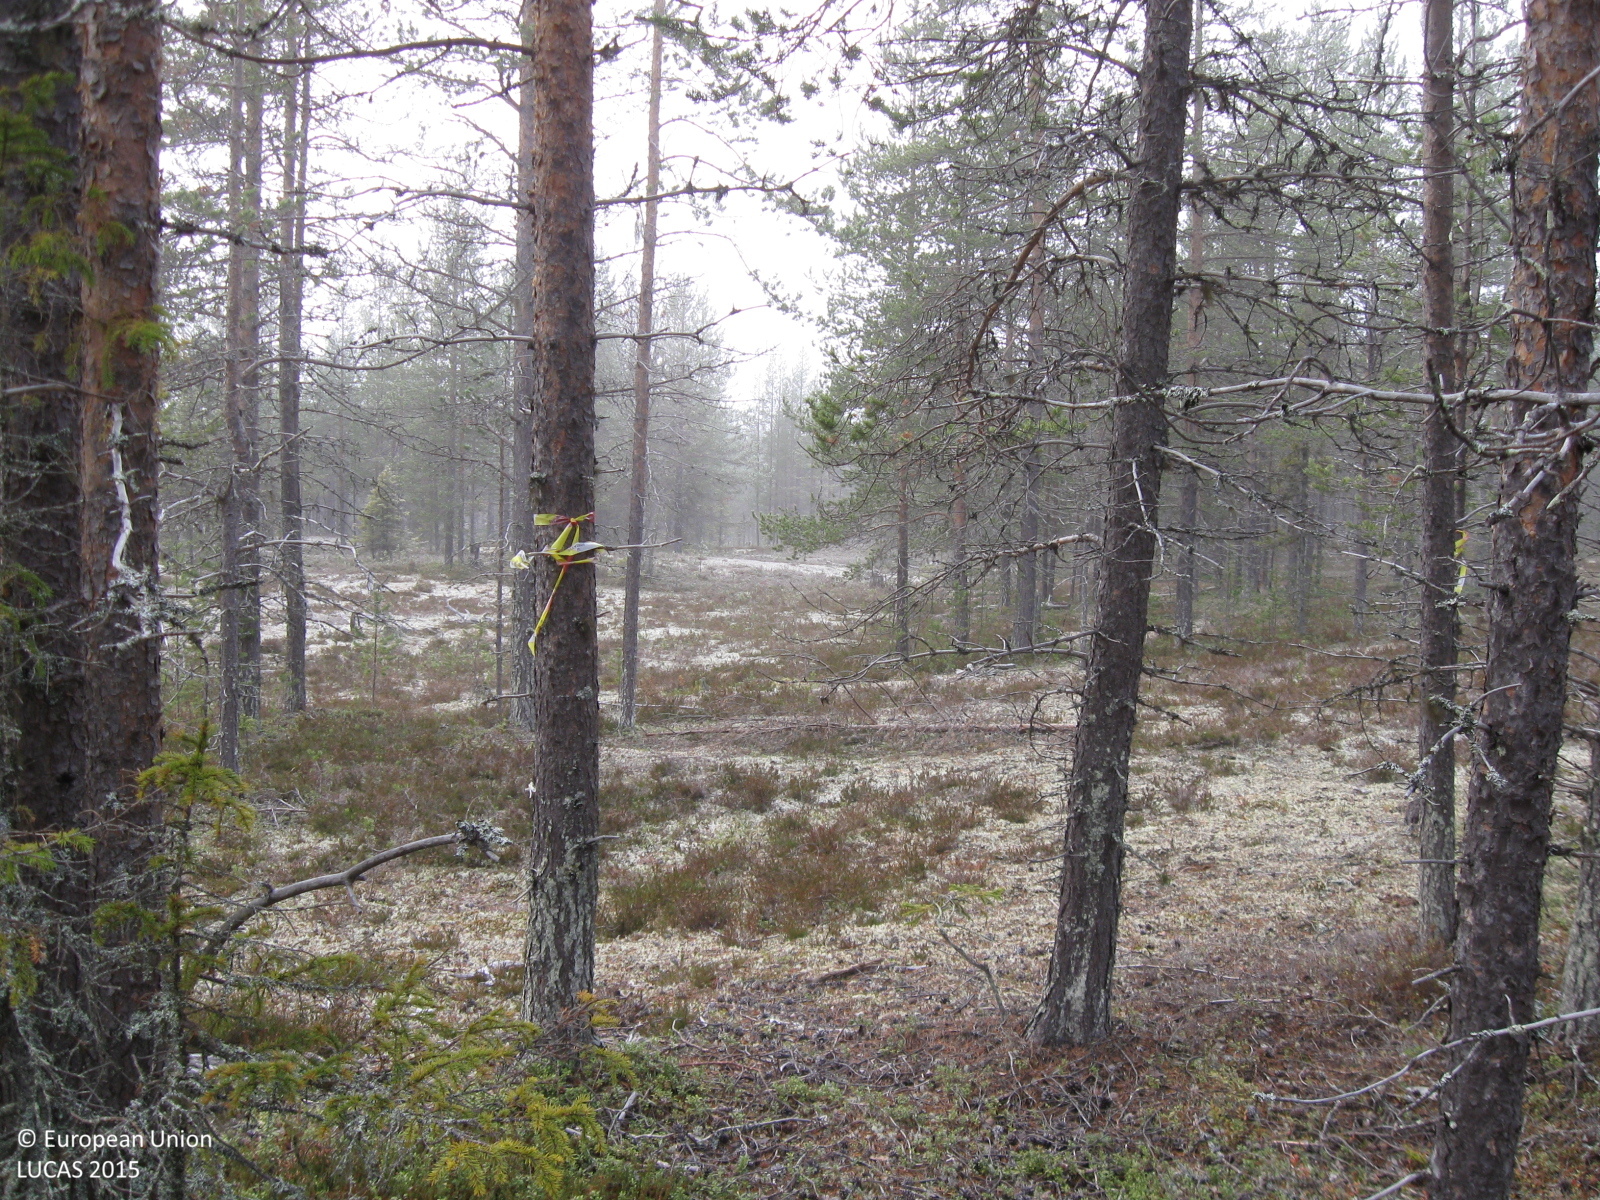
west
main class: Woodland
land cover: Pine dominated coniferous woodland
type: boreal forest
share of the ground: 50 - 75 %
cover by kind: coniferous forest trees 60 %, shrubs 15 %, herbaceous plants 10 %, lichens and mosses 10 %, consolidated bare surface 5 %
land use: Forestry
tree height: > 5 m
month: October
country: SE
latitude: 66.3813
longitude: 21.7087
